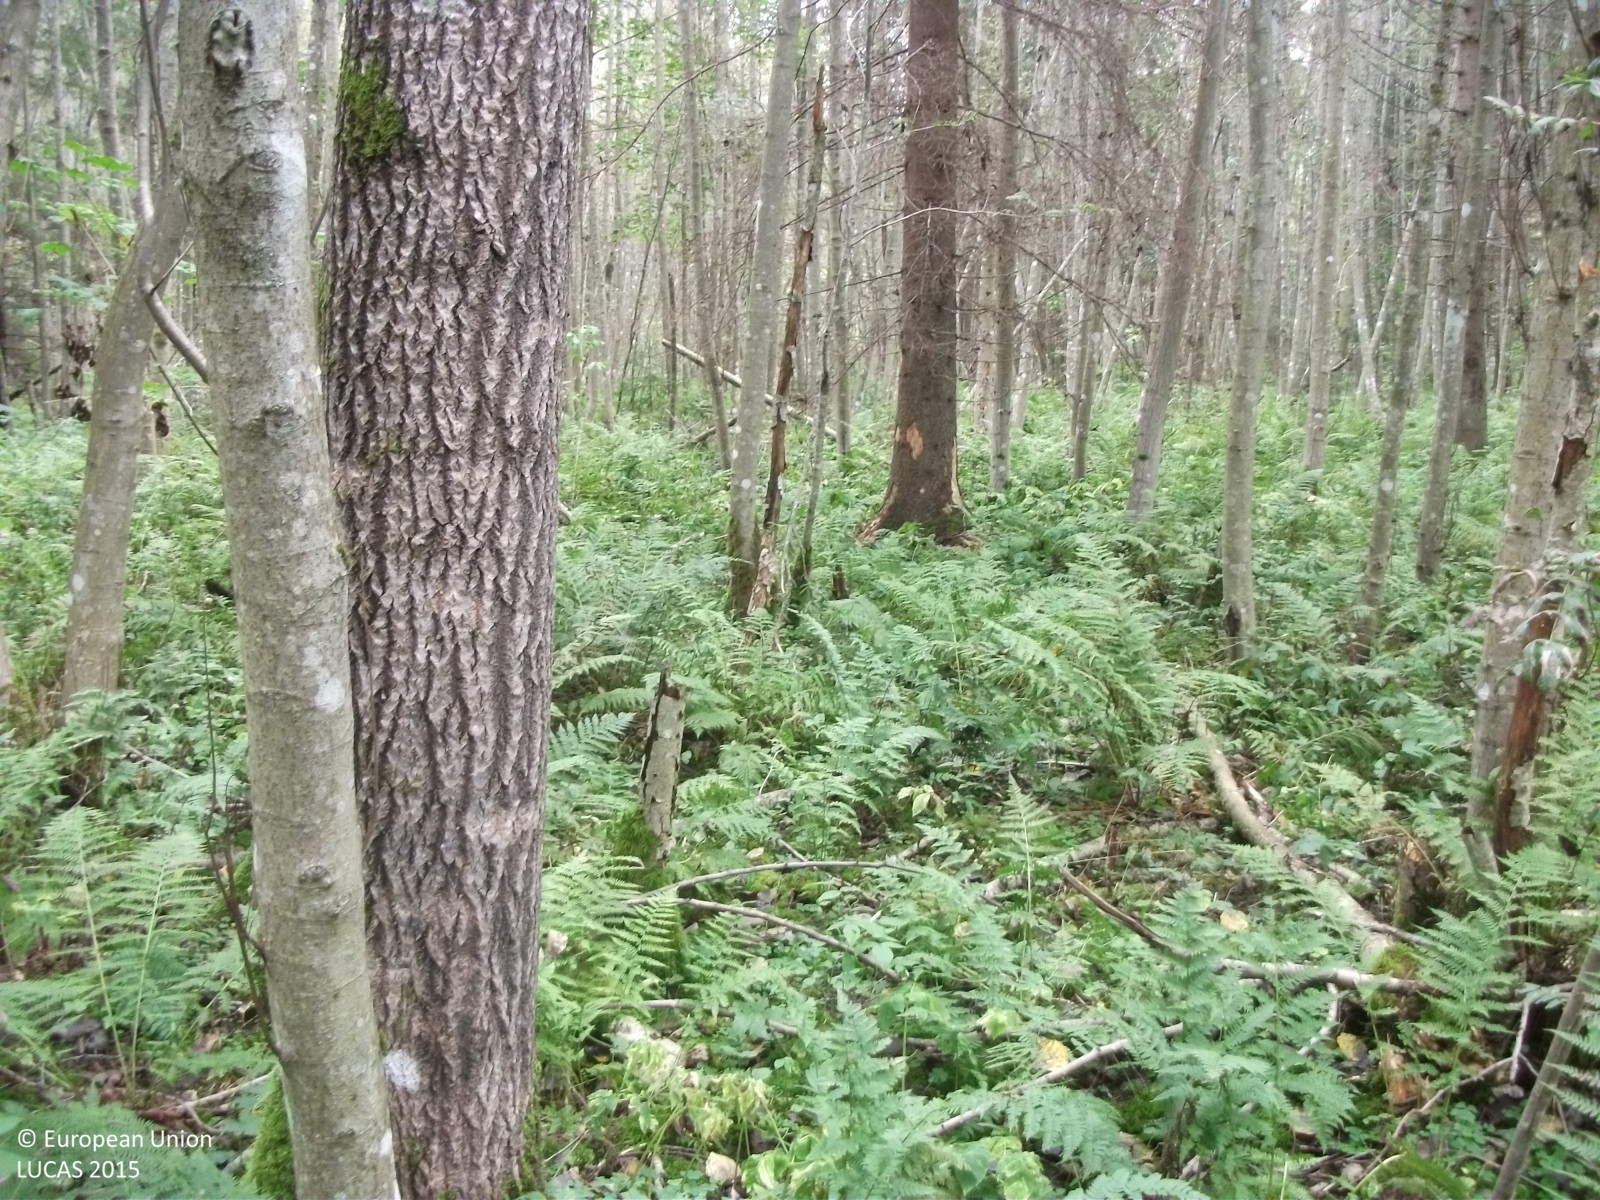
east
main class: Woodland
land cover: Spruce dominated mixed woodland
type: hemiboreal forest and nemoral coniferous forest and mixed broadleaved-coniferous forest
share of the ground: > 75 %
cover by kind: broadleaved forest trees 70 %, coniferous forest trees 25 %, herbaceous plants 5 %
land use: Forestry
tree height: > 5 m
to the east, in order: Spruce dominated mixed woodland; Other mixed woodland; Broadleaved woodland; Other mixed woodland; Broadleaved woodland
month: September
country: LV
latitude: 57.6803
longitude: 24.5297
